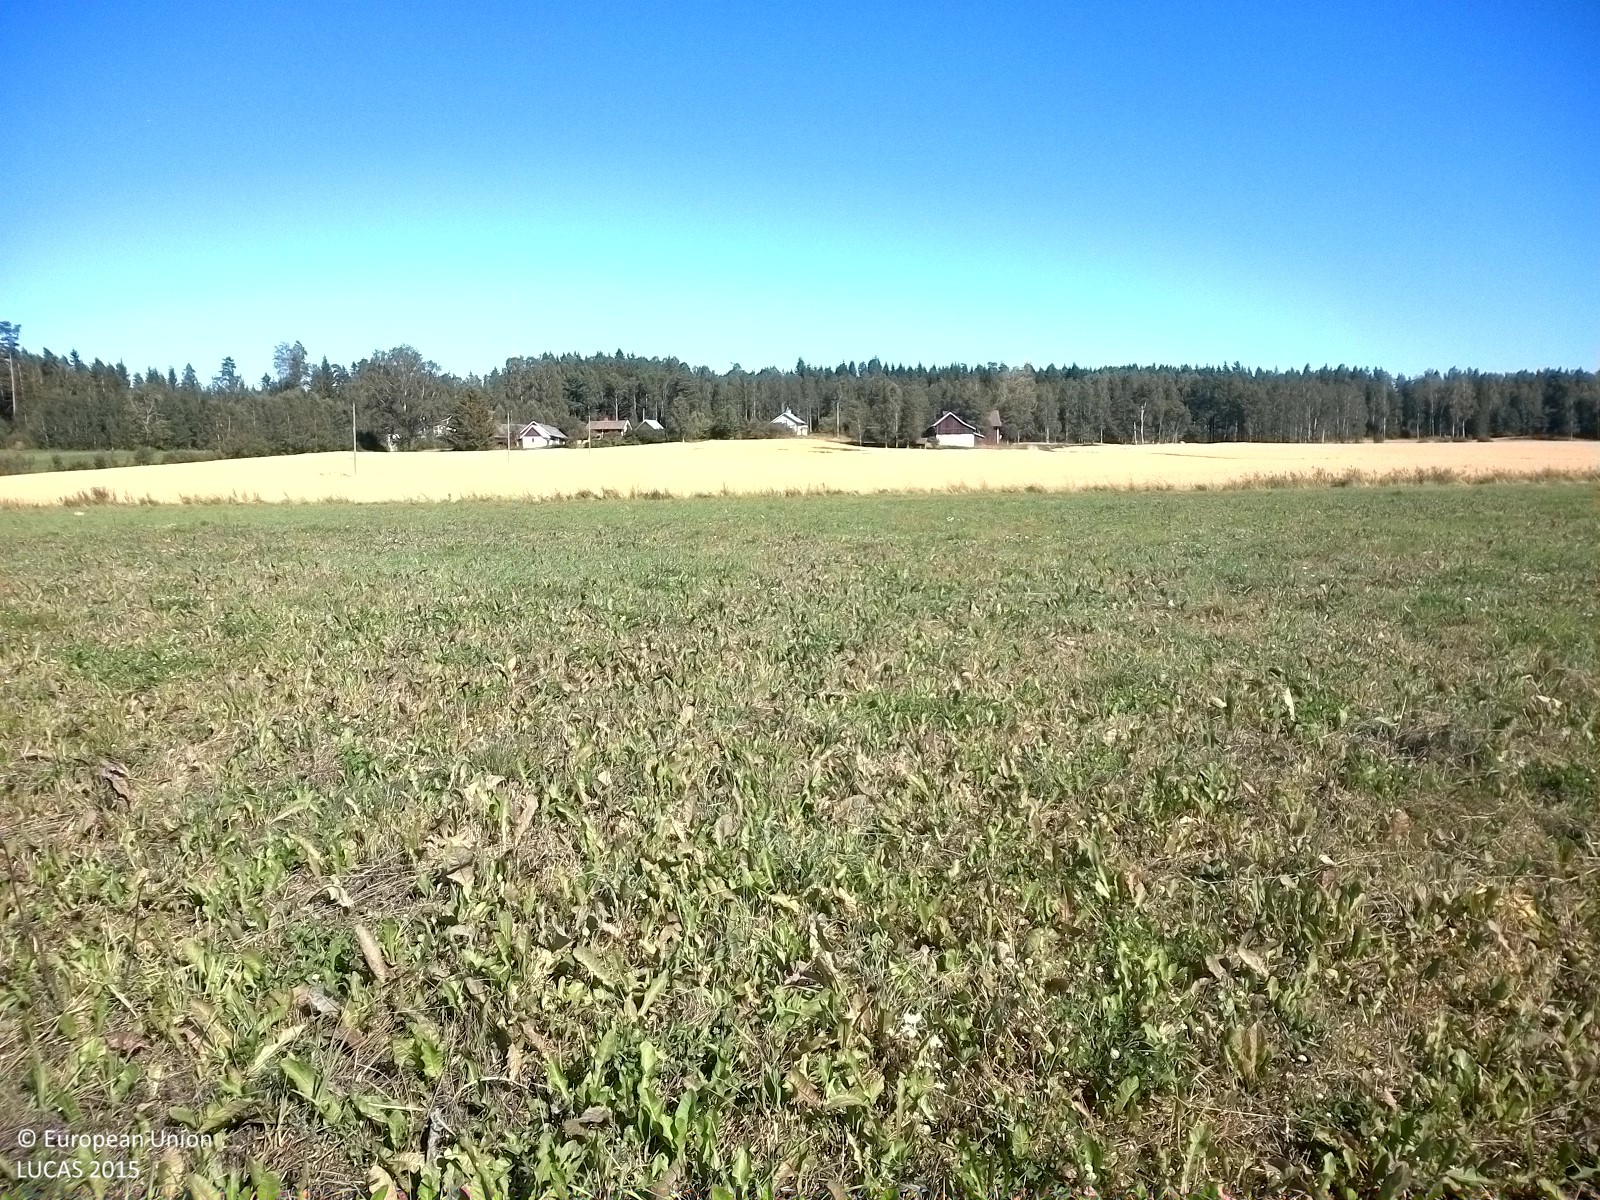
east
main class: Grassland
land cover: Grassland without tree/shrub cover
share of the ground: > 75 %
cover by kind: herbaceous plants 100 %
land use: Agriculture (excluding fallow land and kitchen gardens)
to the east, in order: Grassland without tree/shrub cover; Oats
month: August
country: SE
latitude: 59.3845
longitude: 15.1141
